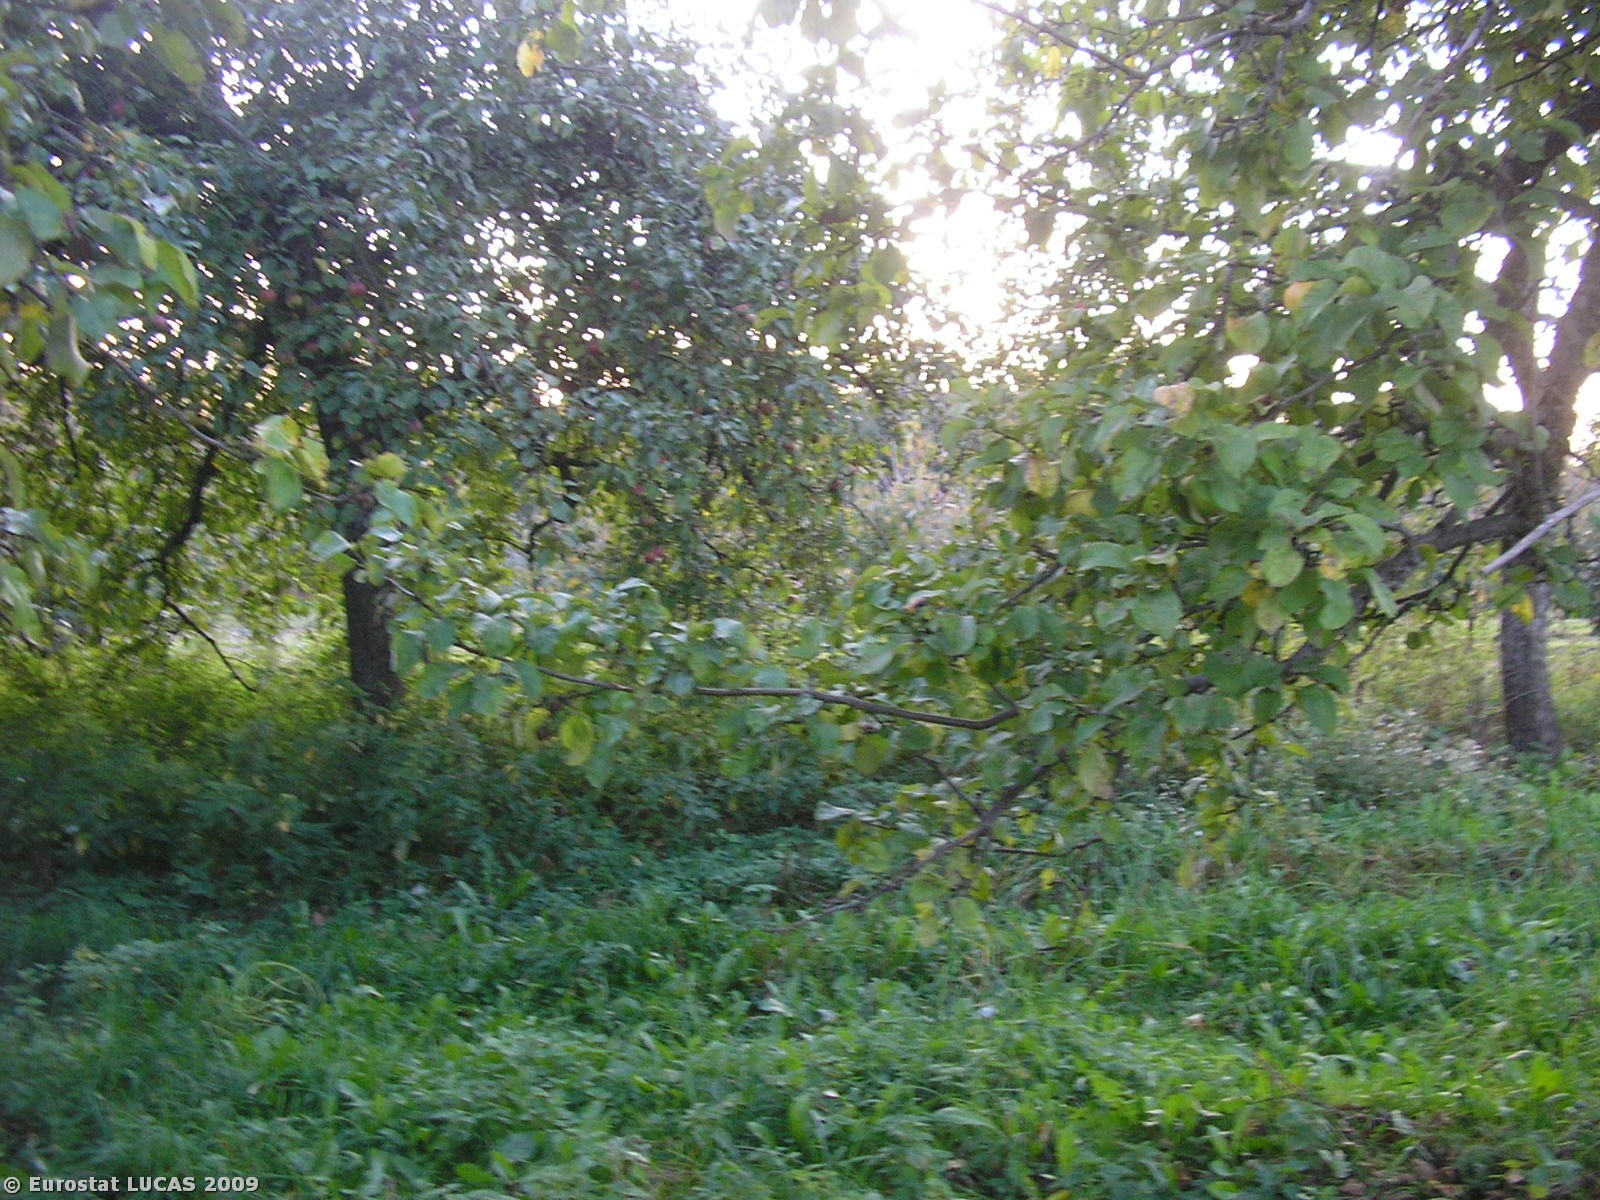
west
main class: Cropland
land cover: Apple fruit
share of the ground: 50 - 75 %
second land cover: Grassland with sparse tree/shrub cover
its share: > 75 %
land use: Agriculture (excluding fallow land and kitchen gardens)
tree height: < 5 m
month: September
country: PL
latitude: 51.8780
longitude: 20.6589
